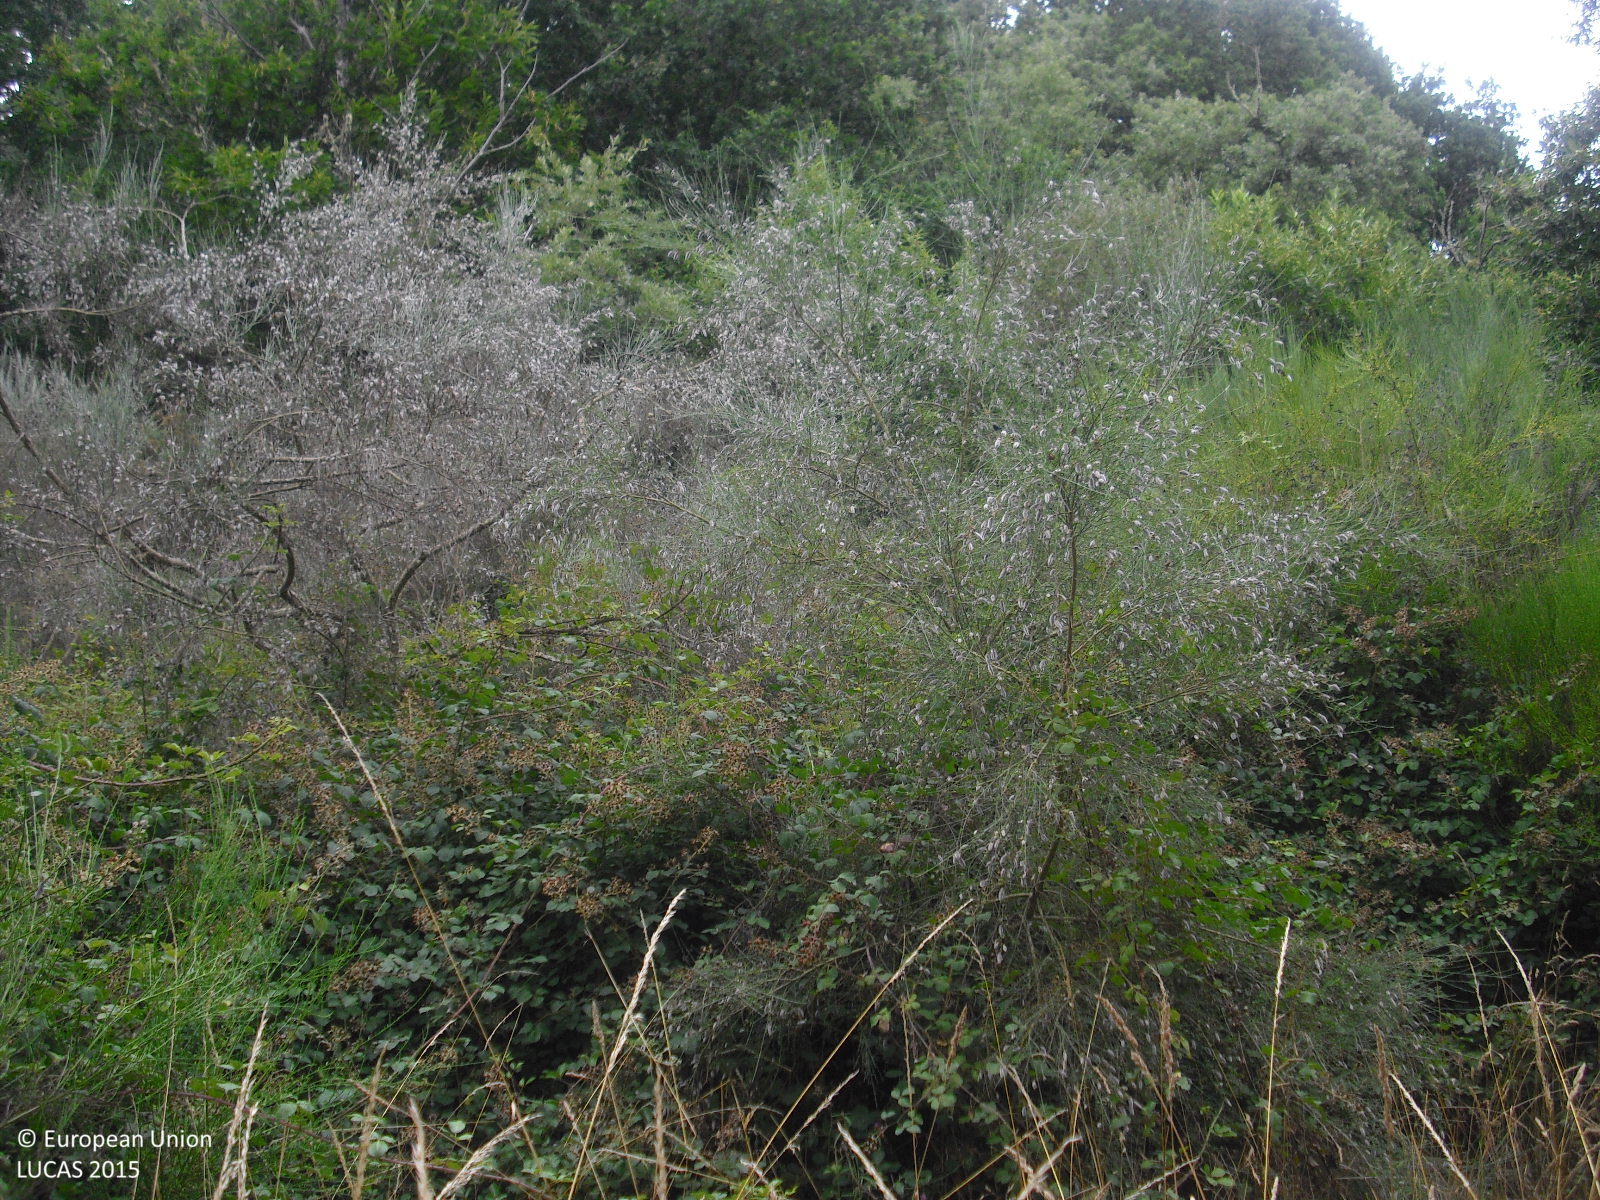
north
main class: Shrubland
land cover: Shrubland without tree cover
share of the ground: > 75 %
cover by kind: shrubs 70 %, herbaceous plants 30 %
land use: Abandoned areas
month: July
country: ES
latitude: 42.3754
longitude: -7.4696
